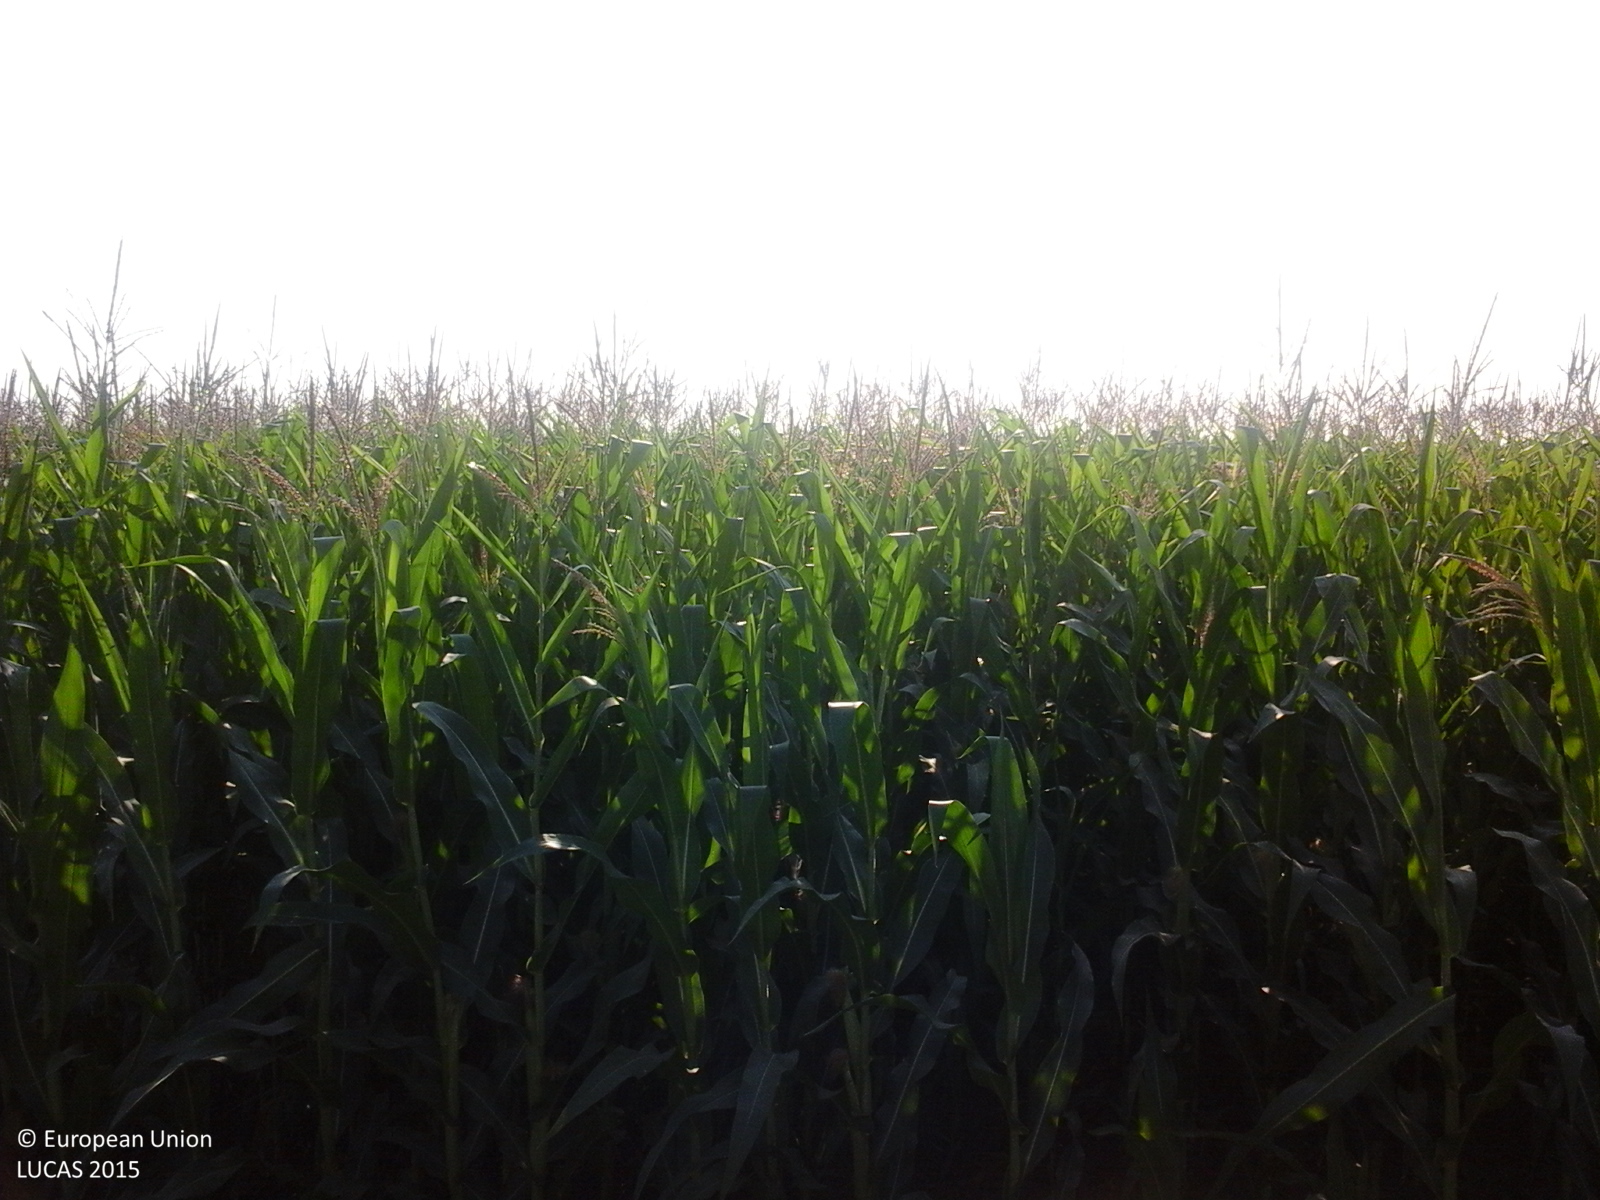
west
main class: Cropland
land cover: Maize
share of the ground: > 75 %
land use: Agriculture (excluding fallow land and kitchen gardens)
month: July
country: RO
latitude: 44.6556
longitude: 27.2760
